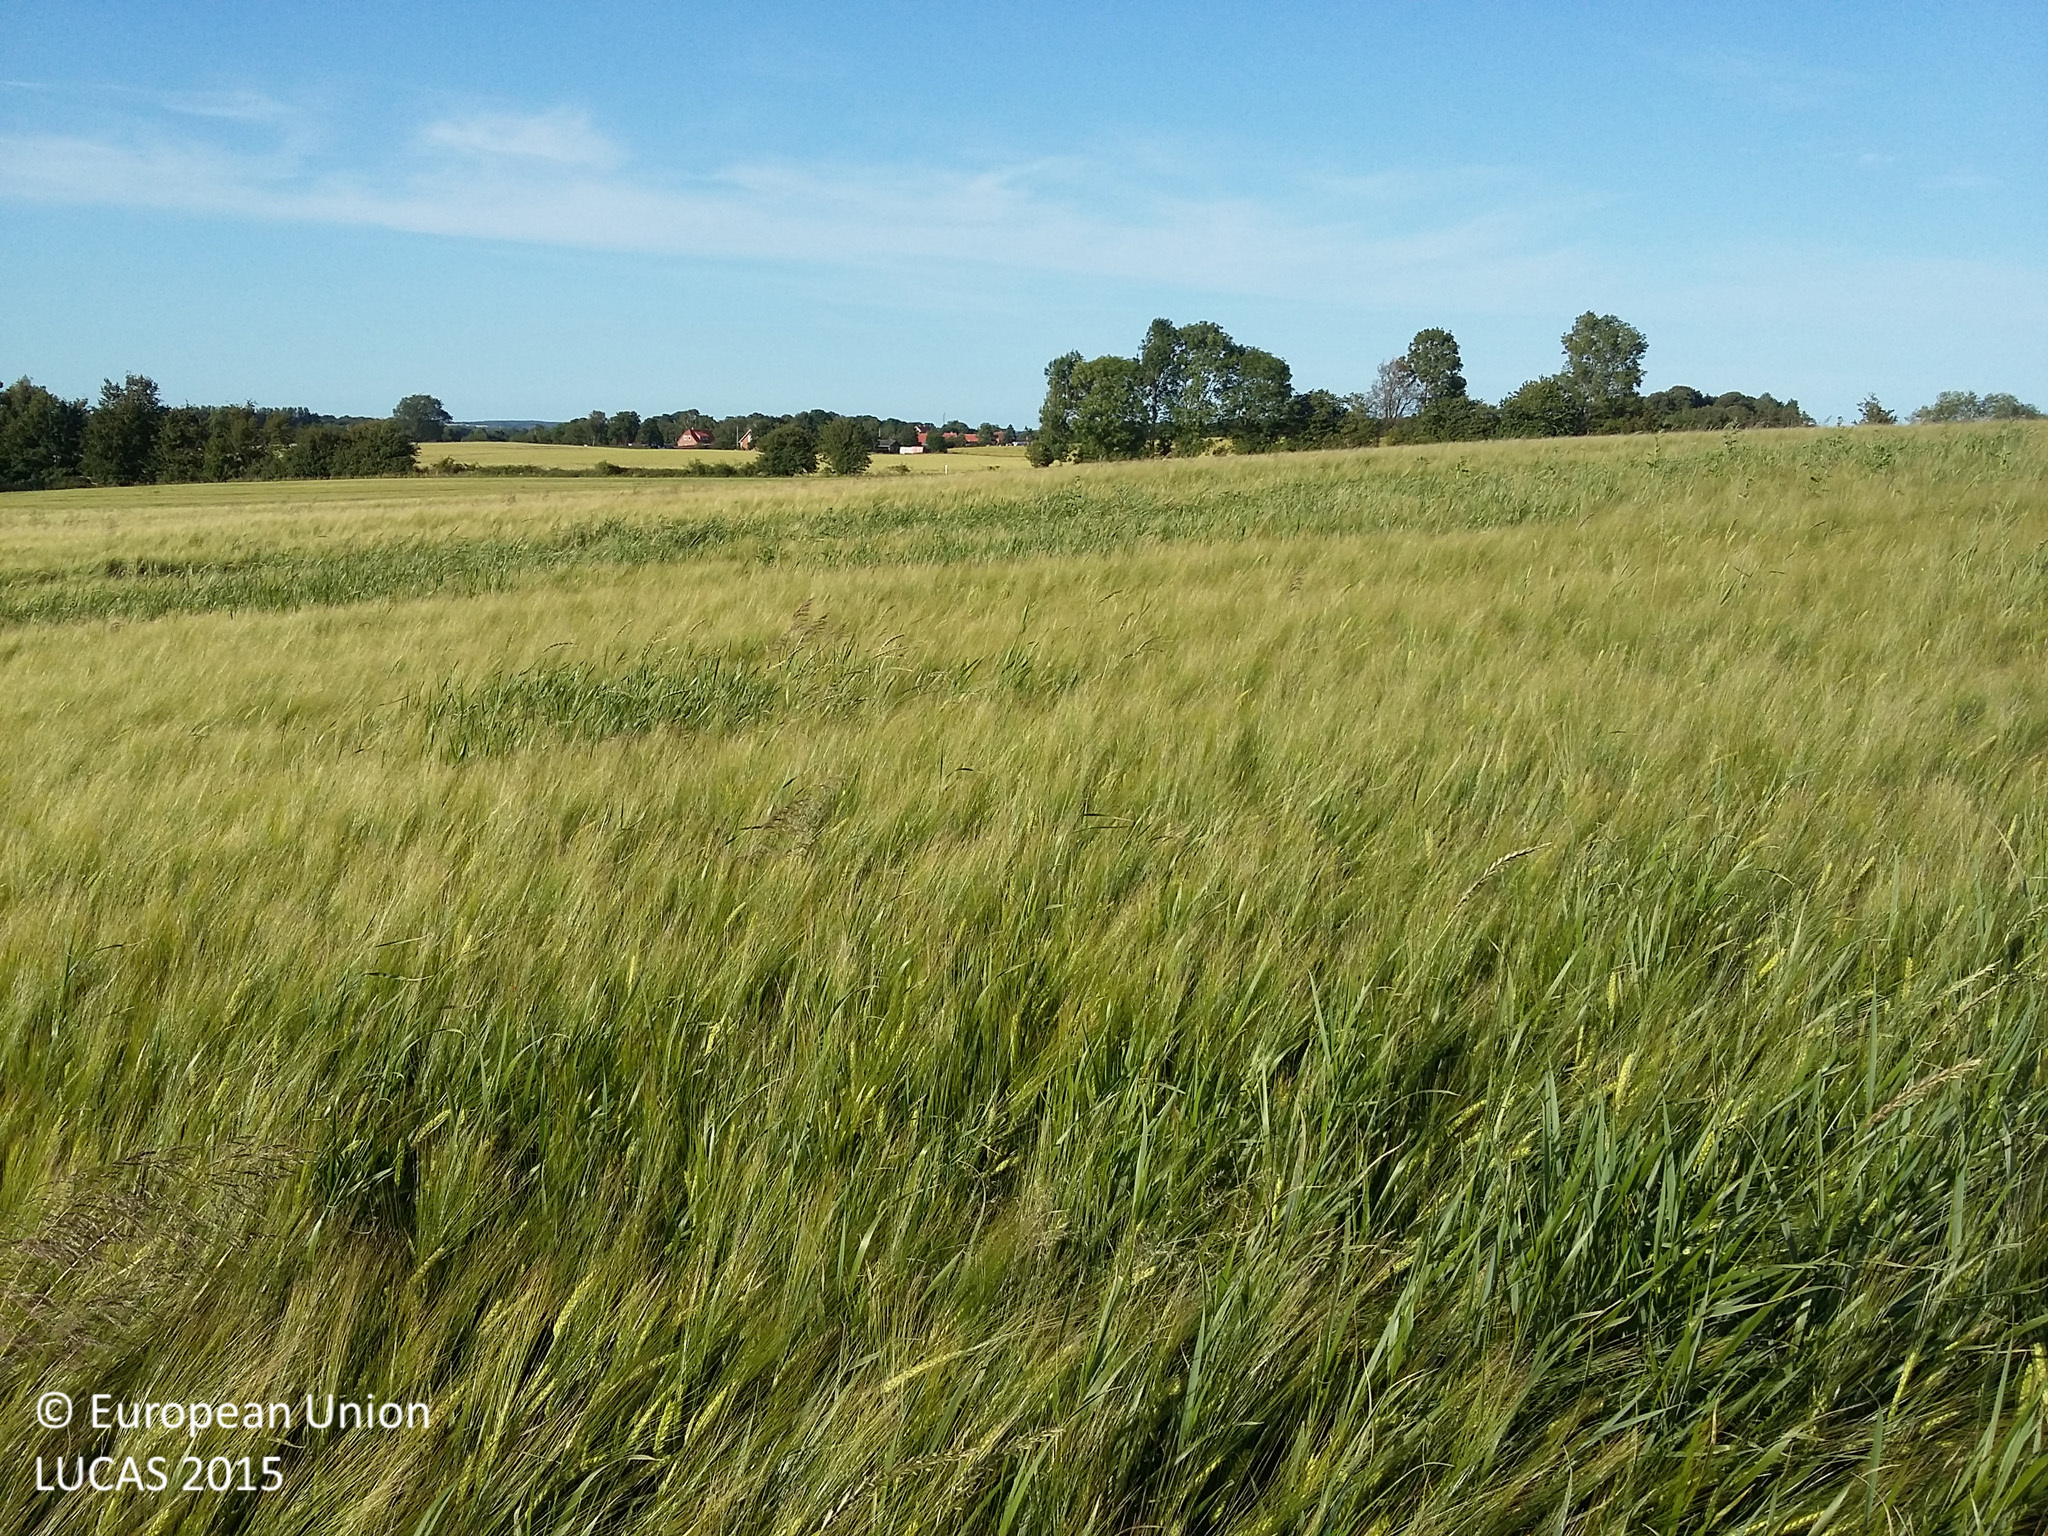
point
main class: Cropland
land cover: Barley
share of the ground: > 75 %
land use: Agriculture (excluding fallow land and kitchen gardens)
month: July
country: DK
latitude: 55.6571
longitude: 11.5403
